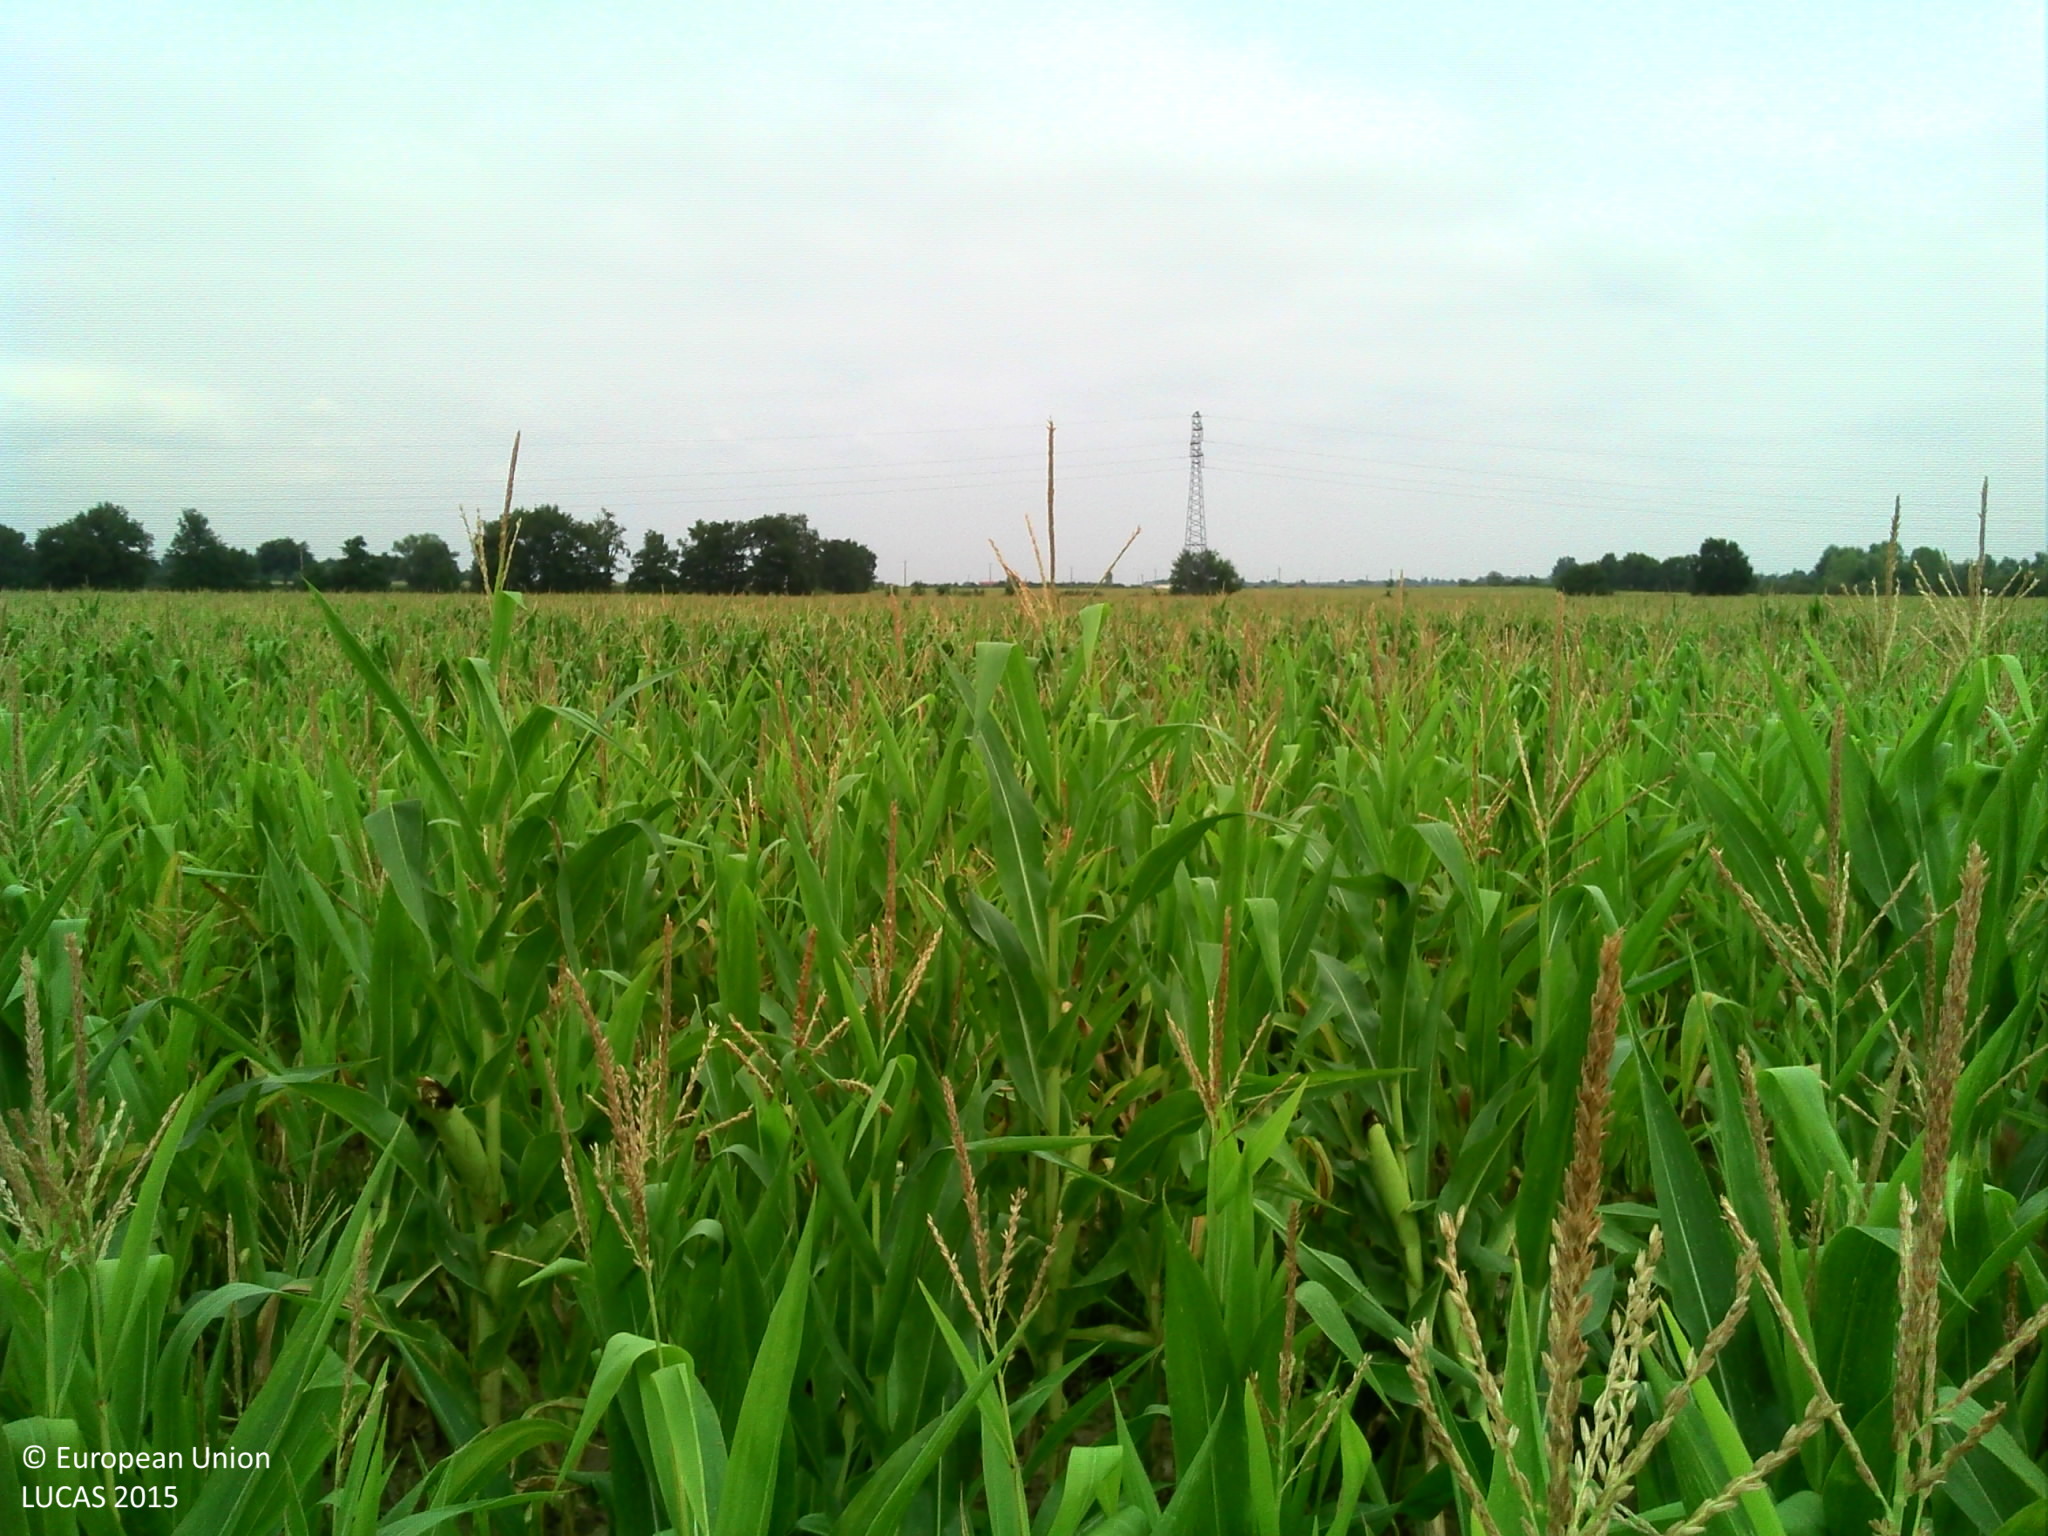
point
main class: Cropland
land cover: Maize
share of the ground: 50 - 75 %
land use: Agriculture (excluding fallow land and kitchen gardens)
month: August
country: FR
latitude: 45.6307
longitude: 4.1408
